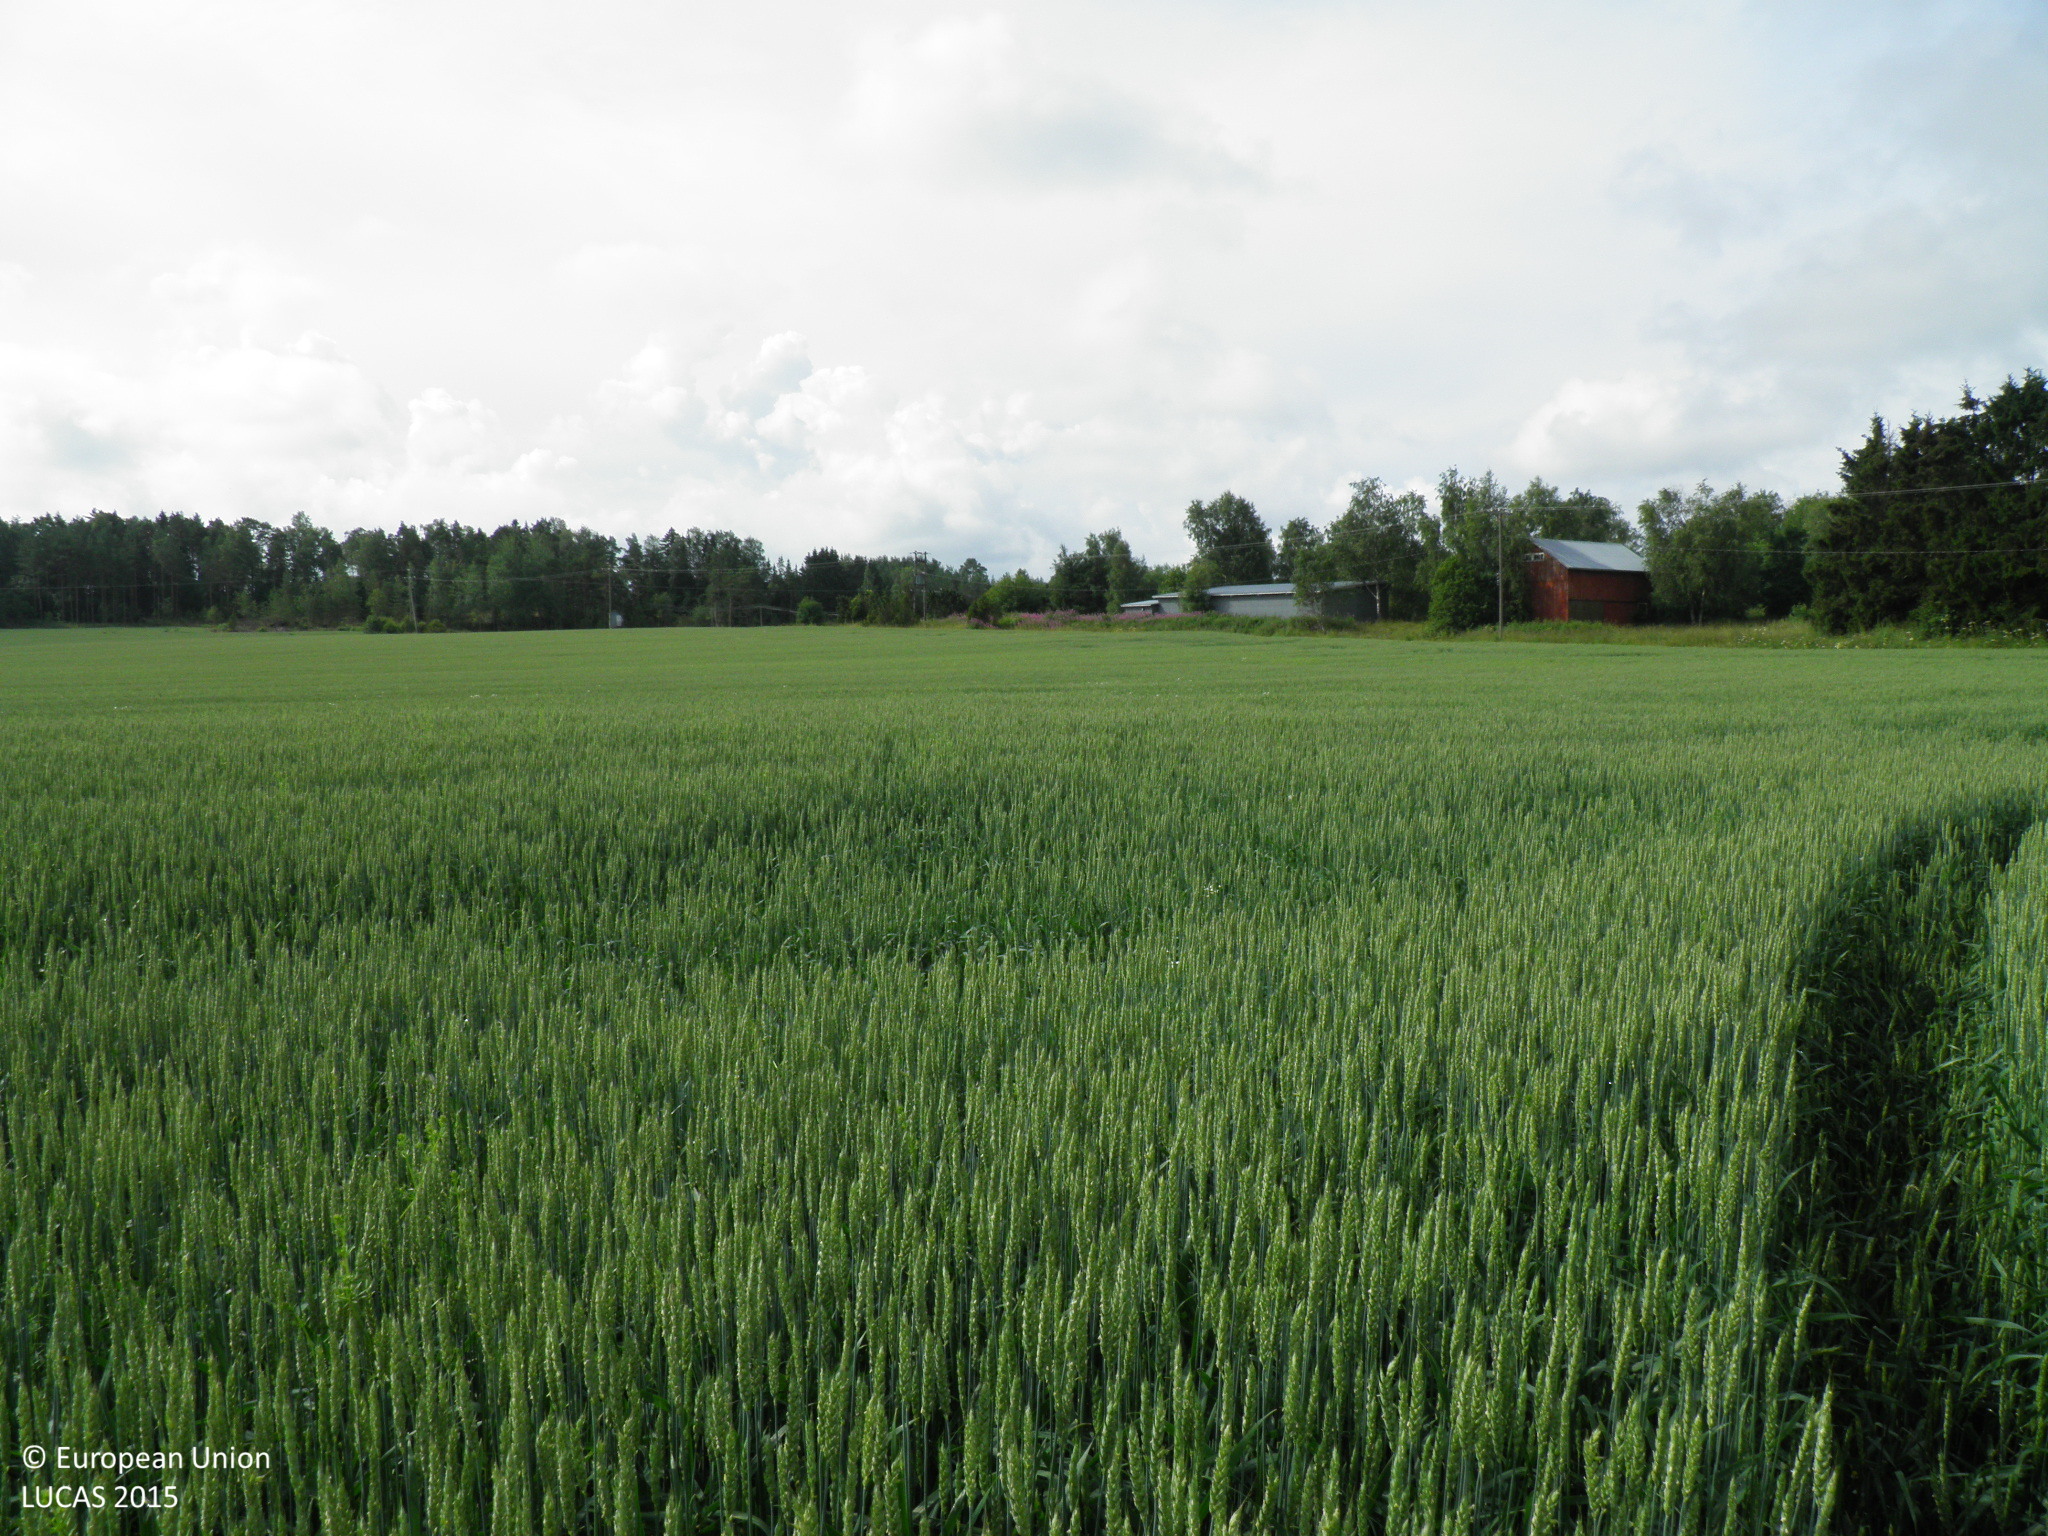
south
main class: Cropland
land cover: Common wheat
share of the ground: > 75 %
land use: Agriculture (excluding fallow land and kitchen gardens)
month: July
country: FI
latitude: 60.6867
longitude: 21.5740
